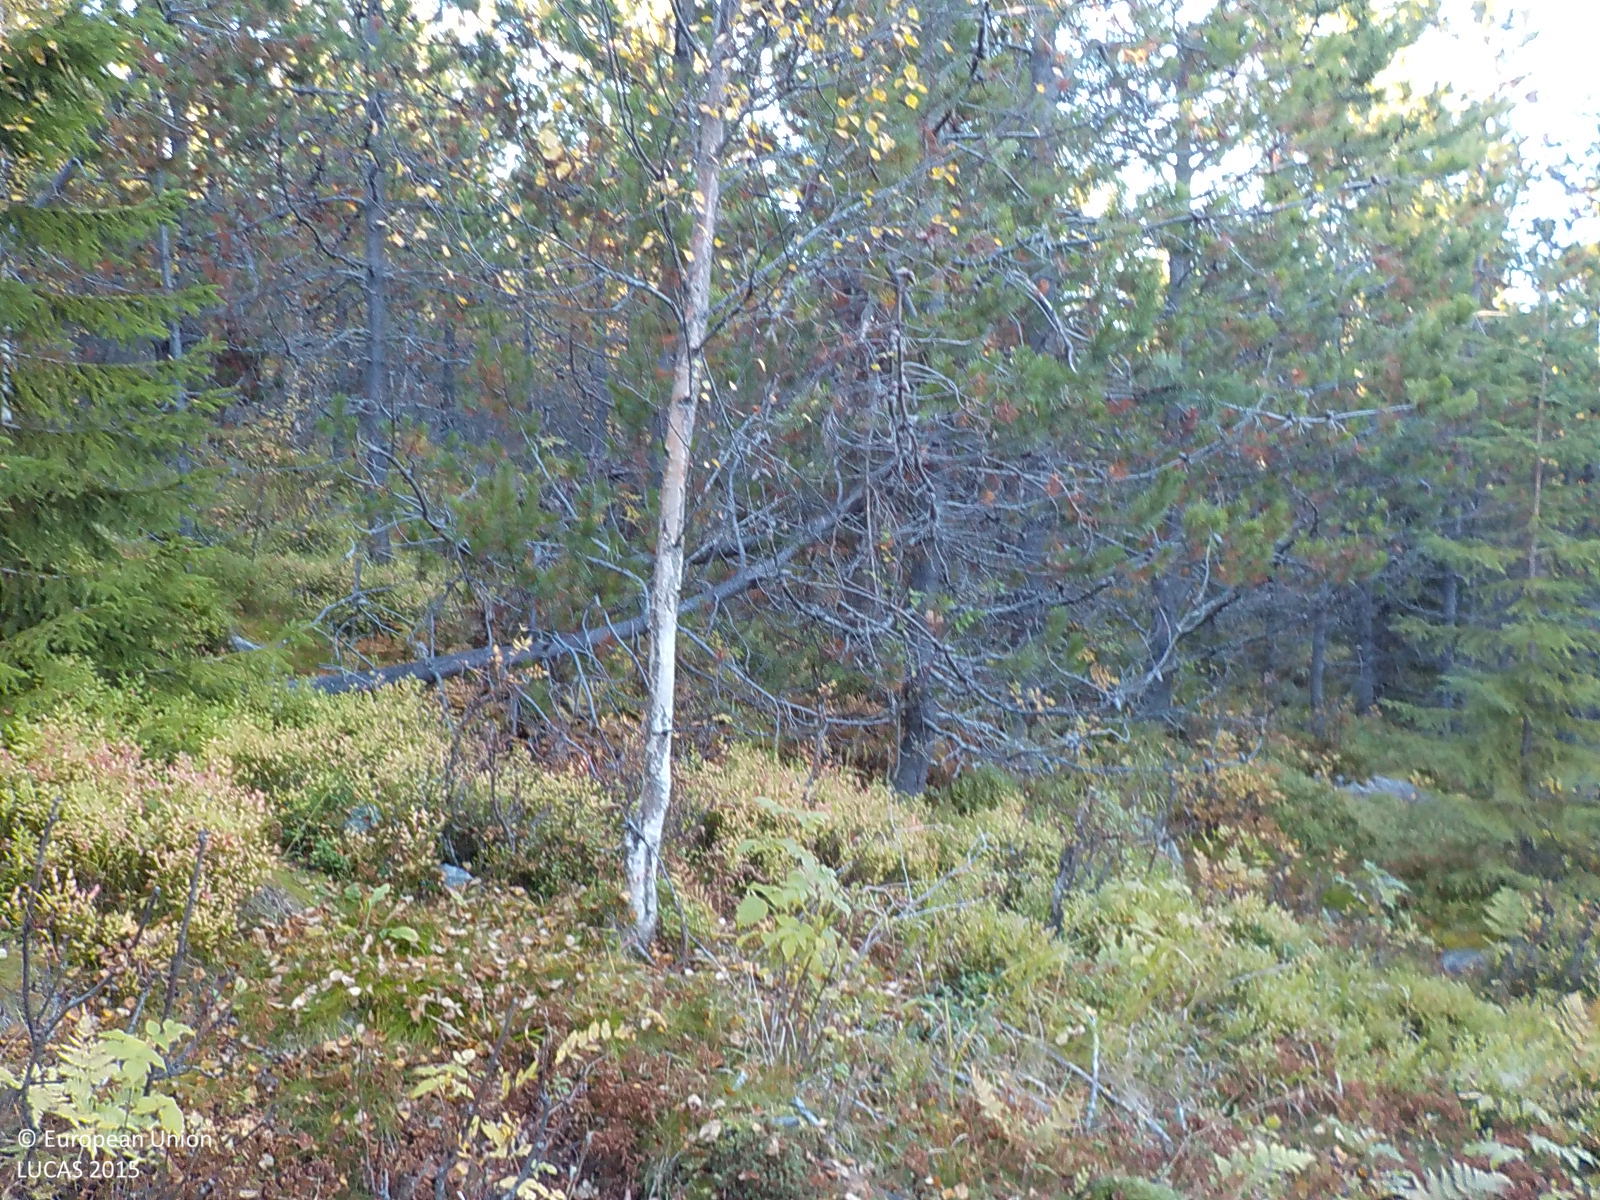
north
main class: Woodland
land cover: Pine dominated coniferous woodland
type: exotic forest
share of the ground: > 75 %
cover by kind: coniferous forest trees 75 %, shrubs 10 %, herbaceous plants 10 %, lichens and mosses 5 %
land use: Forestry
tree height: > 5 m
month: September
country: SE
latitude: 63.4740
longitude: 17.1789
